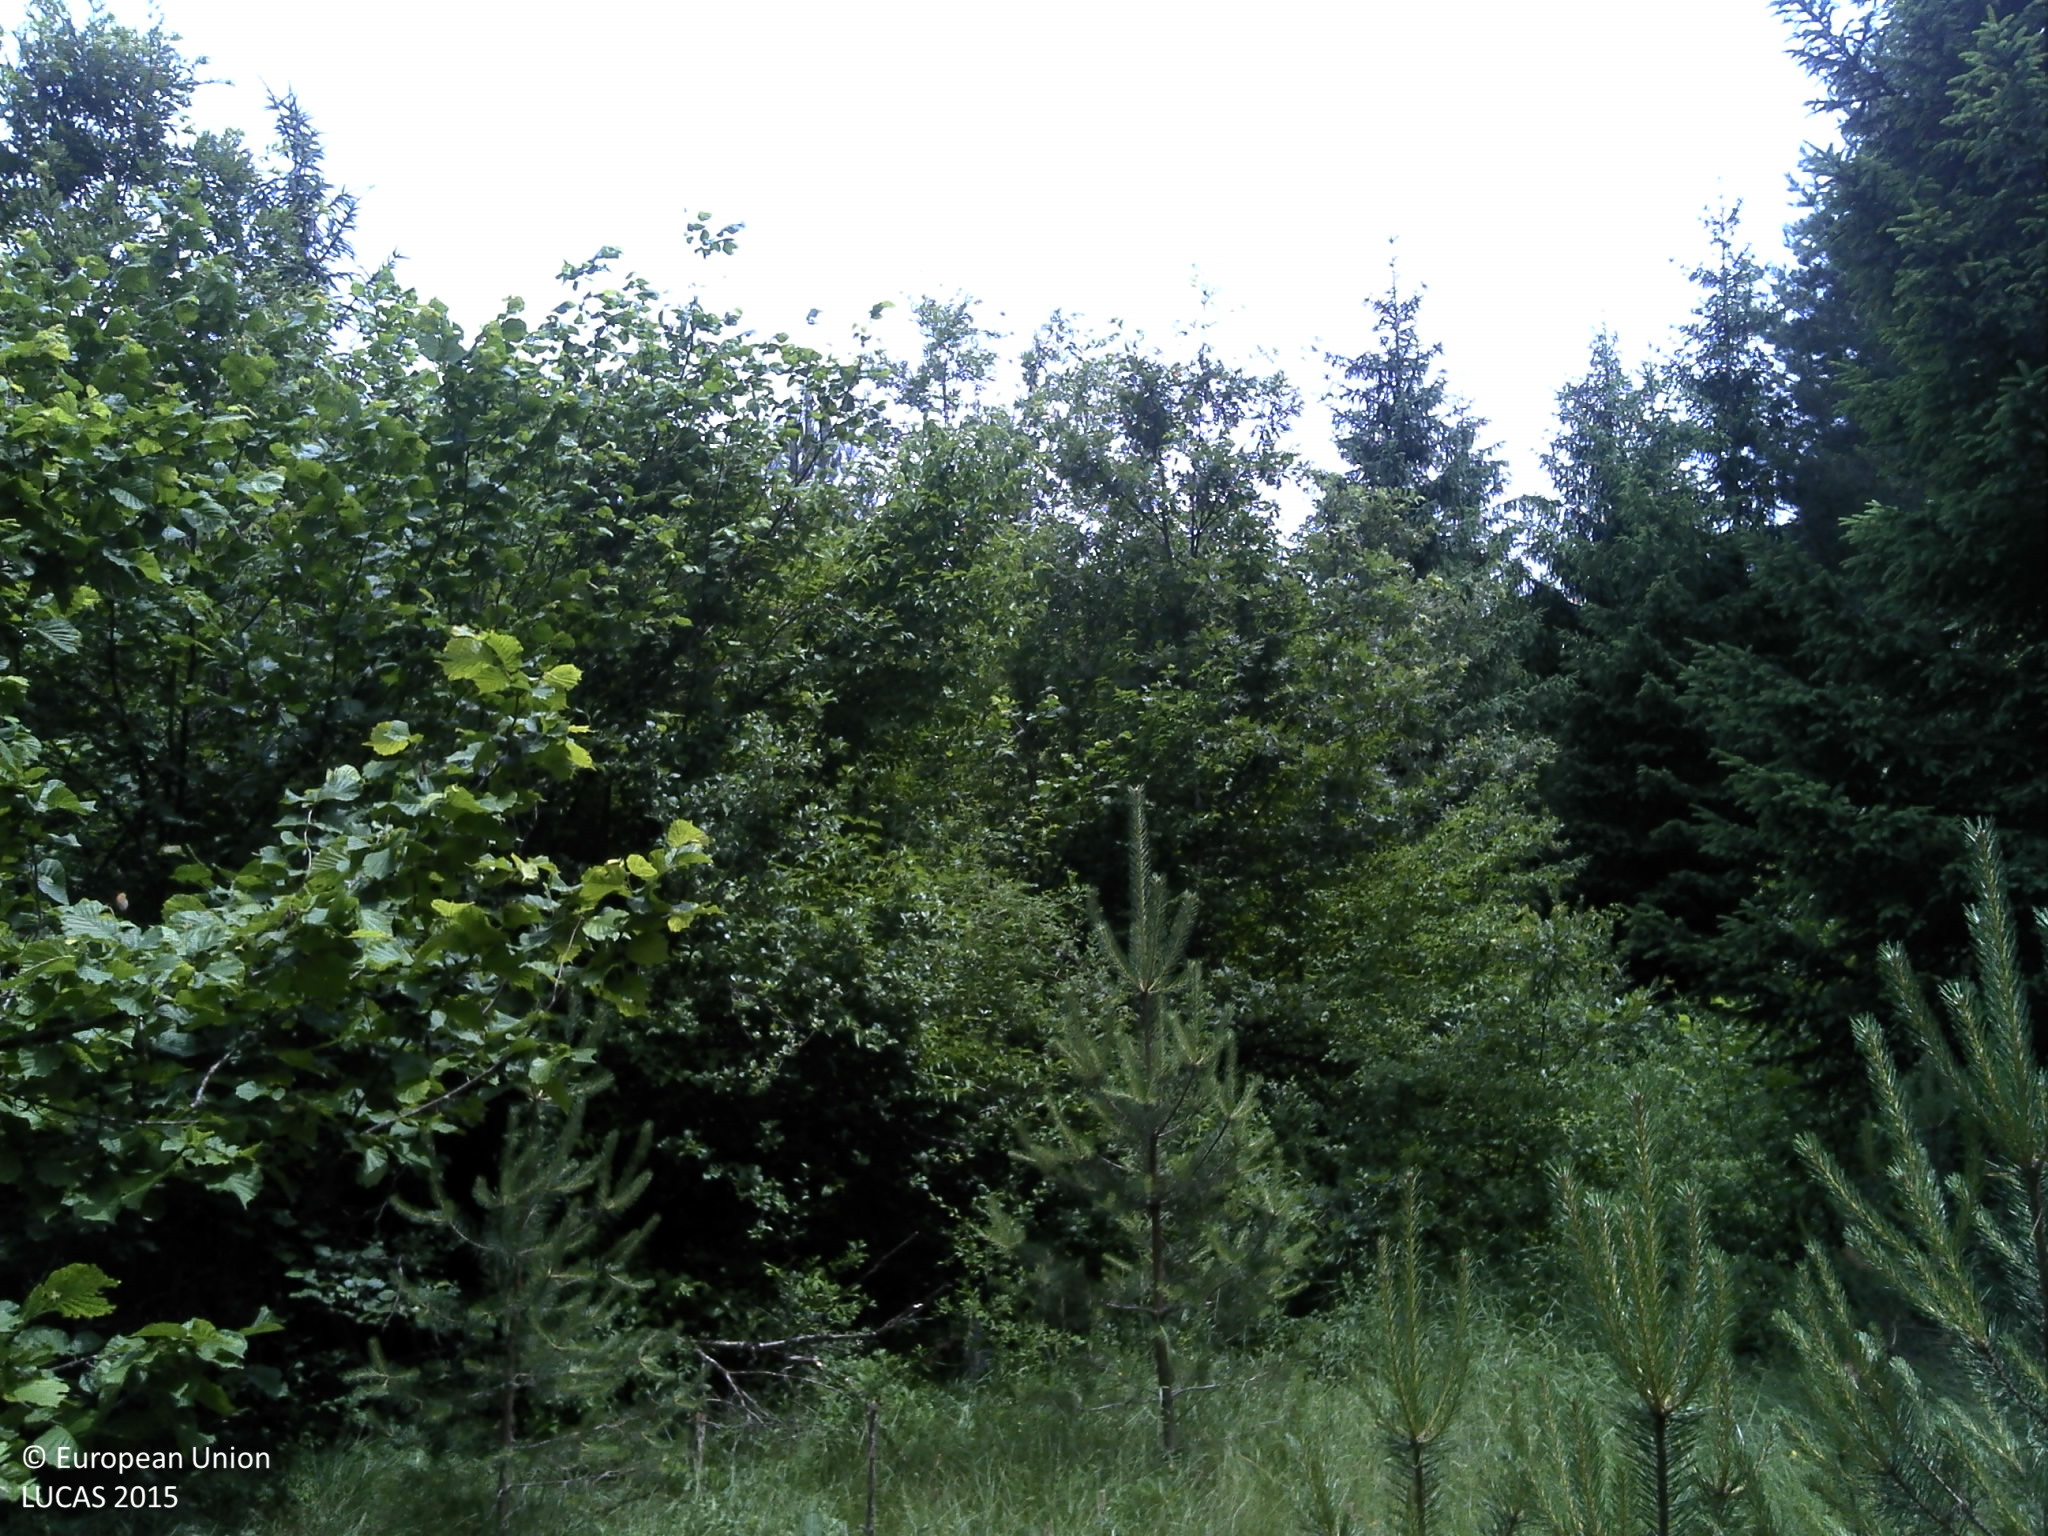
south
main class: Woodland
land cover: Pine dominated coniferous woodland
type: hemiboreal forest and nemoral coniferous forest and mixed broadleaved-coniferous forest
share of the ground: 50 - 75 %
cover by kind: coniferous forest trees 50 %, herbaceous plants 40 %, broadleaved forest trees 10 %
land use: Semi-natural and natural areas not in use
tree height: > 5 m
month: June
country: HR
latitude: 44.4804
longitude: 16.0665
